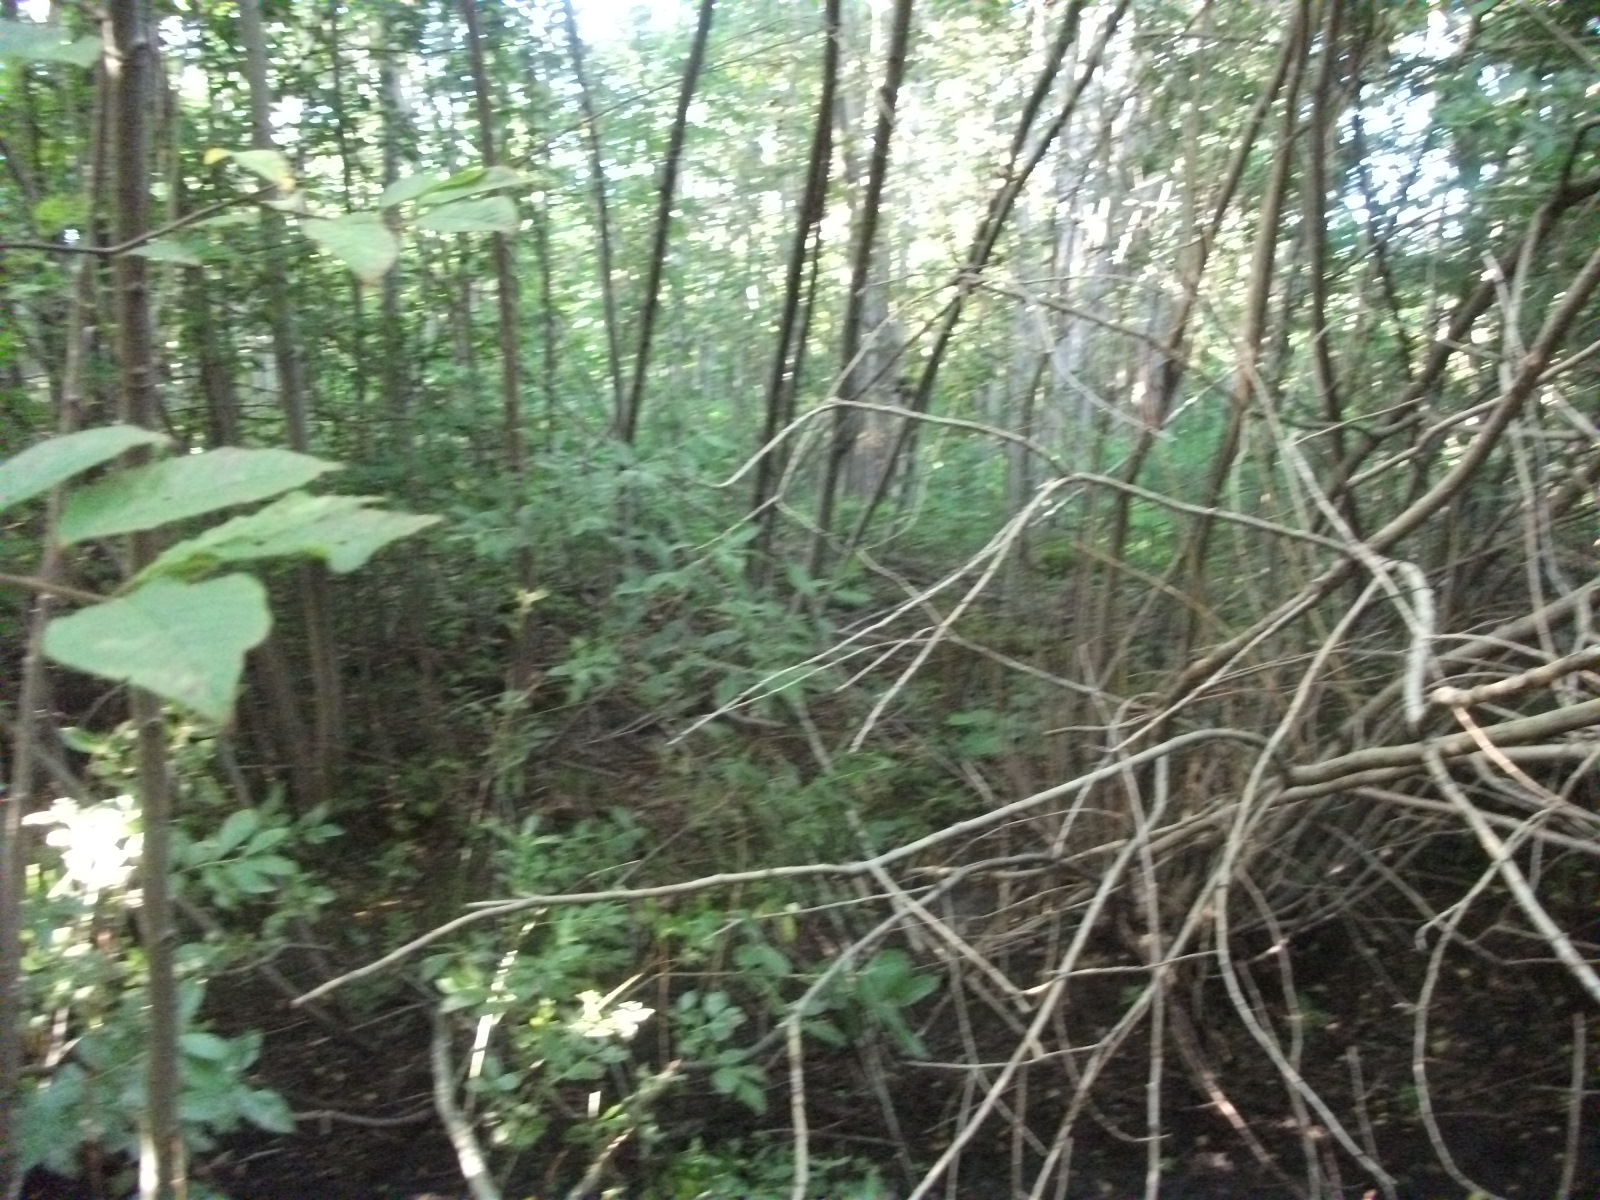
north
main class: Woodland
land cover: Broadleaved woodland
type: non-riverine alder, birch or aspen forest
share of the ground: > 75 %
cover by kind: broadleaved forest trees 95 %, shrubs 5 %
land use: Forestry
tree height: > 5 m
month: August
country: LV
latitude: 56.8900
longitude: 26.2408
